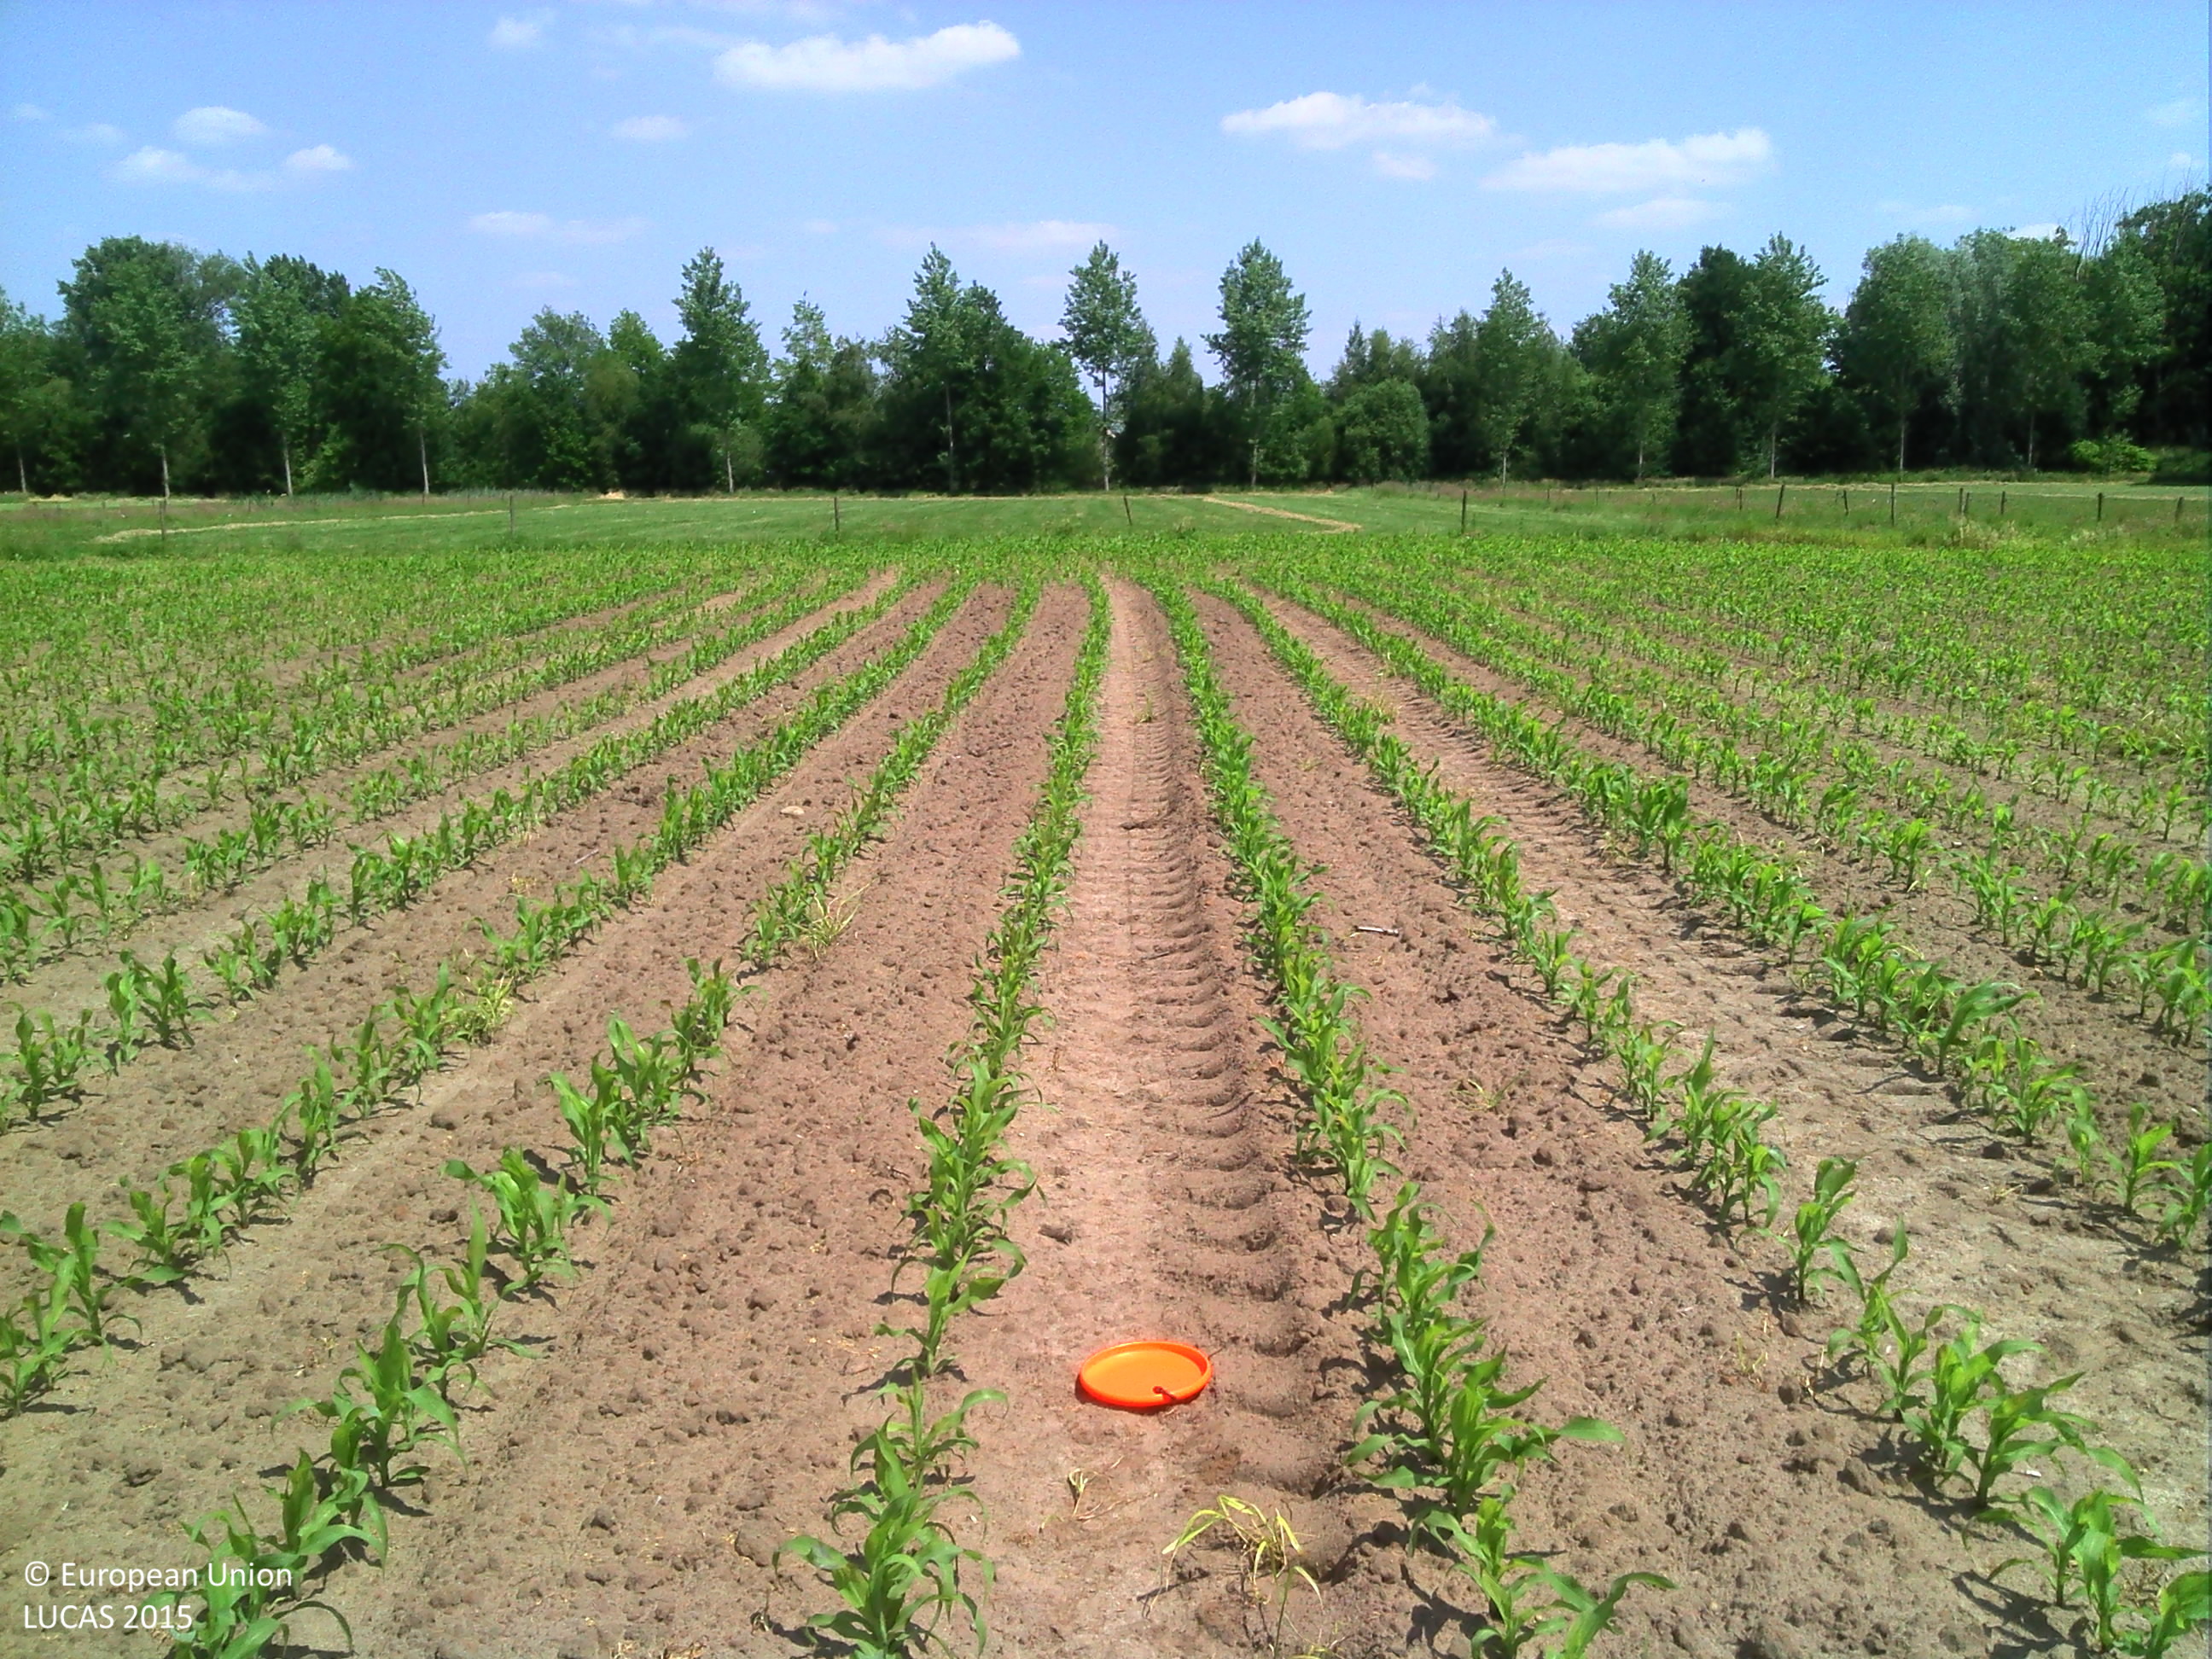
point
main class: Cropland
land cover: Maize
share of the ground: 25 - 50 %
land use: Agriculture (excluding fallow land and kitchen gardens)
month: June
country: BE
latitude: 50.9837
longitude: 5.1971
